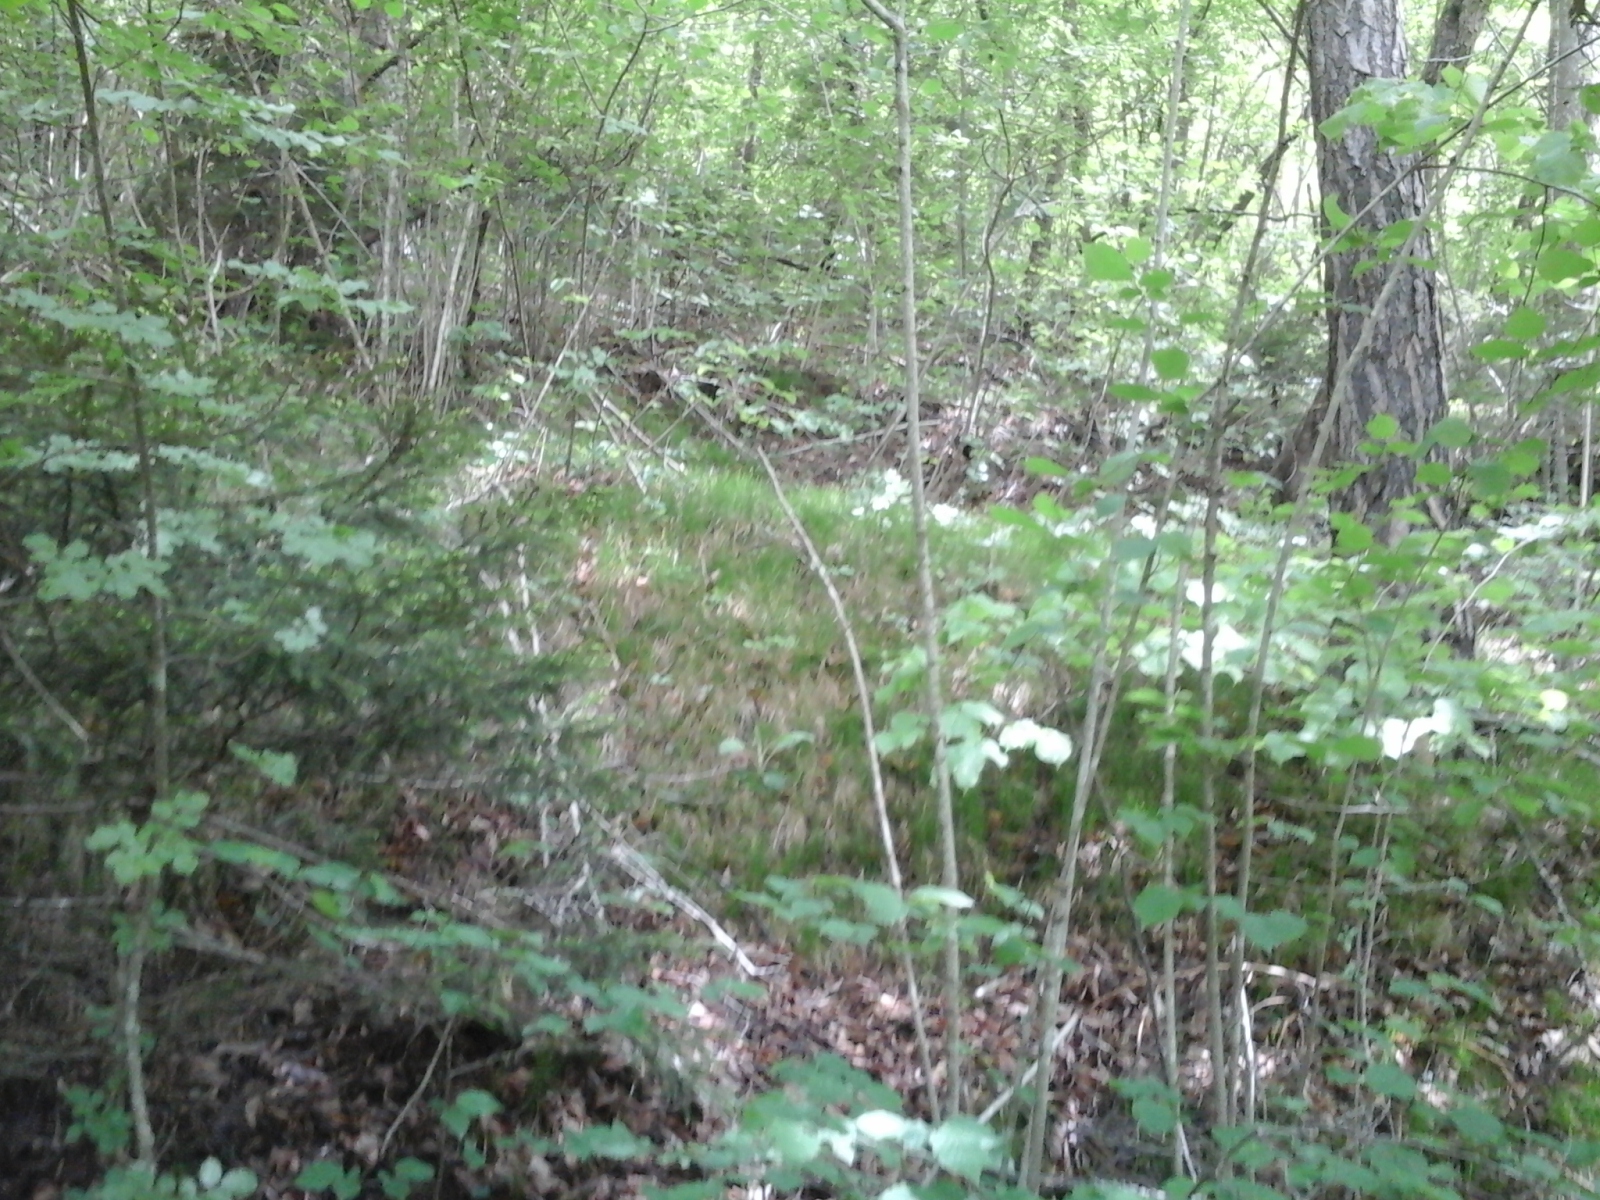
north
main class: Woodland
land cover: Other mixed woodland
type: alpine coniferous forest
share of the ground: > 75 %
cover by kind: broadleaved forest trees 75 %, coniferous forest trees 25 %
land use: Forestry
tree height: > 5 m
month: May
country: IT
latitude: 46.0424
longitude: 10.7355
